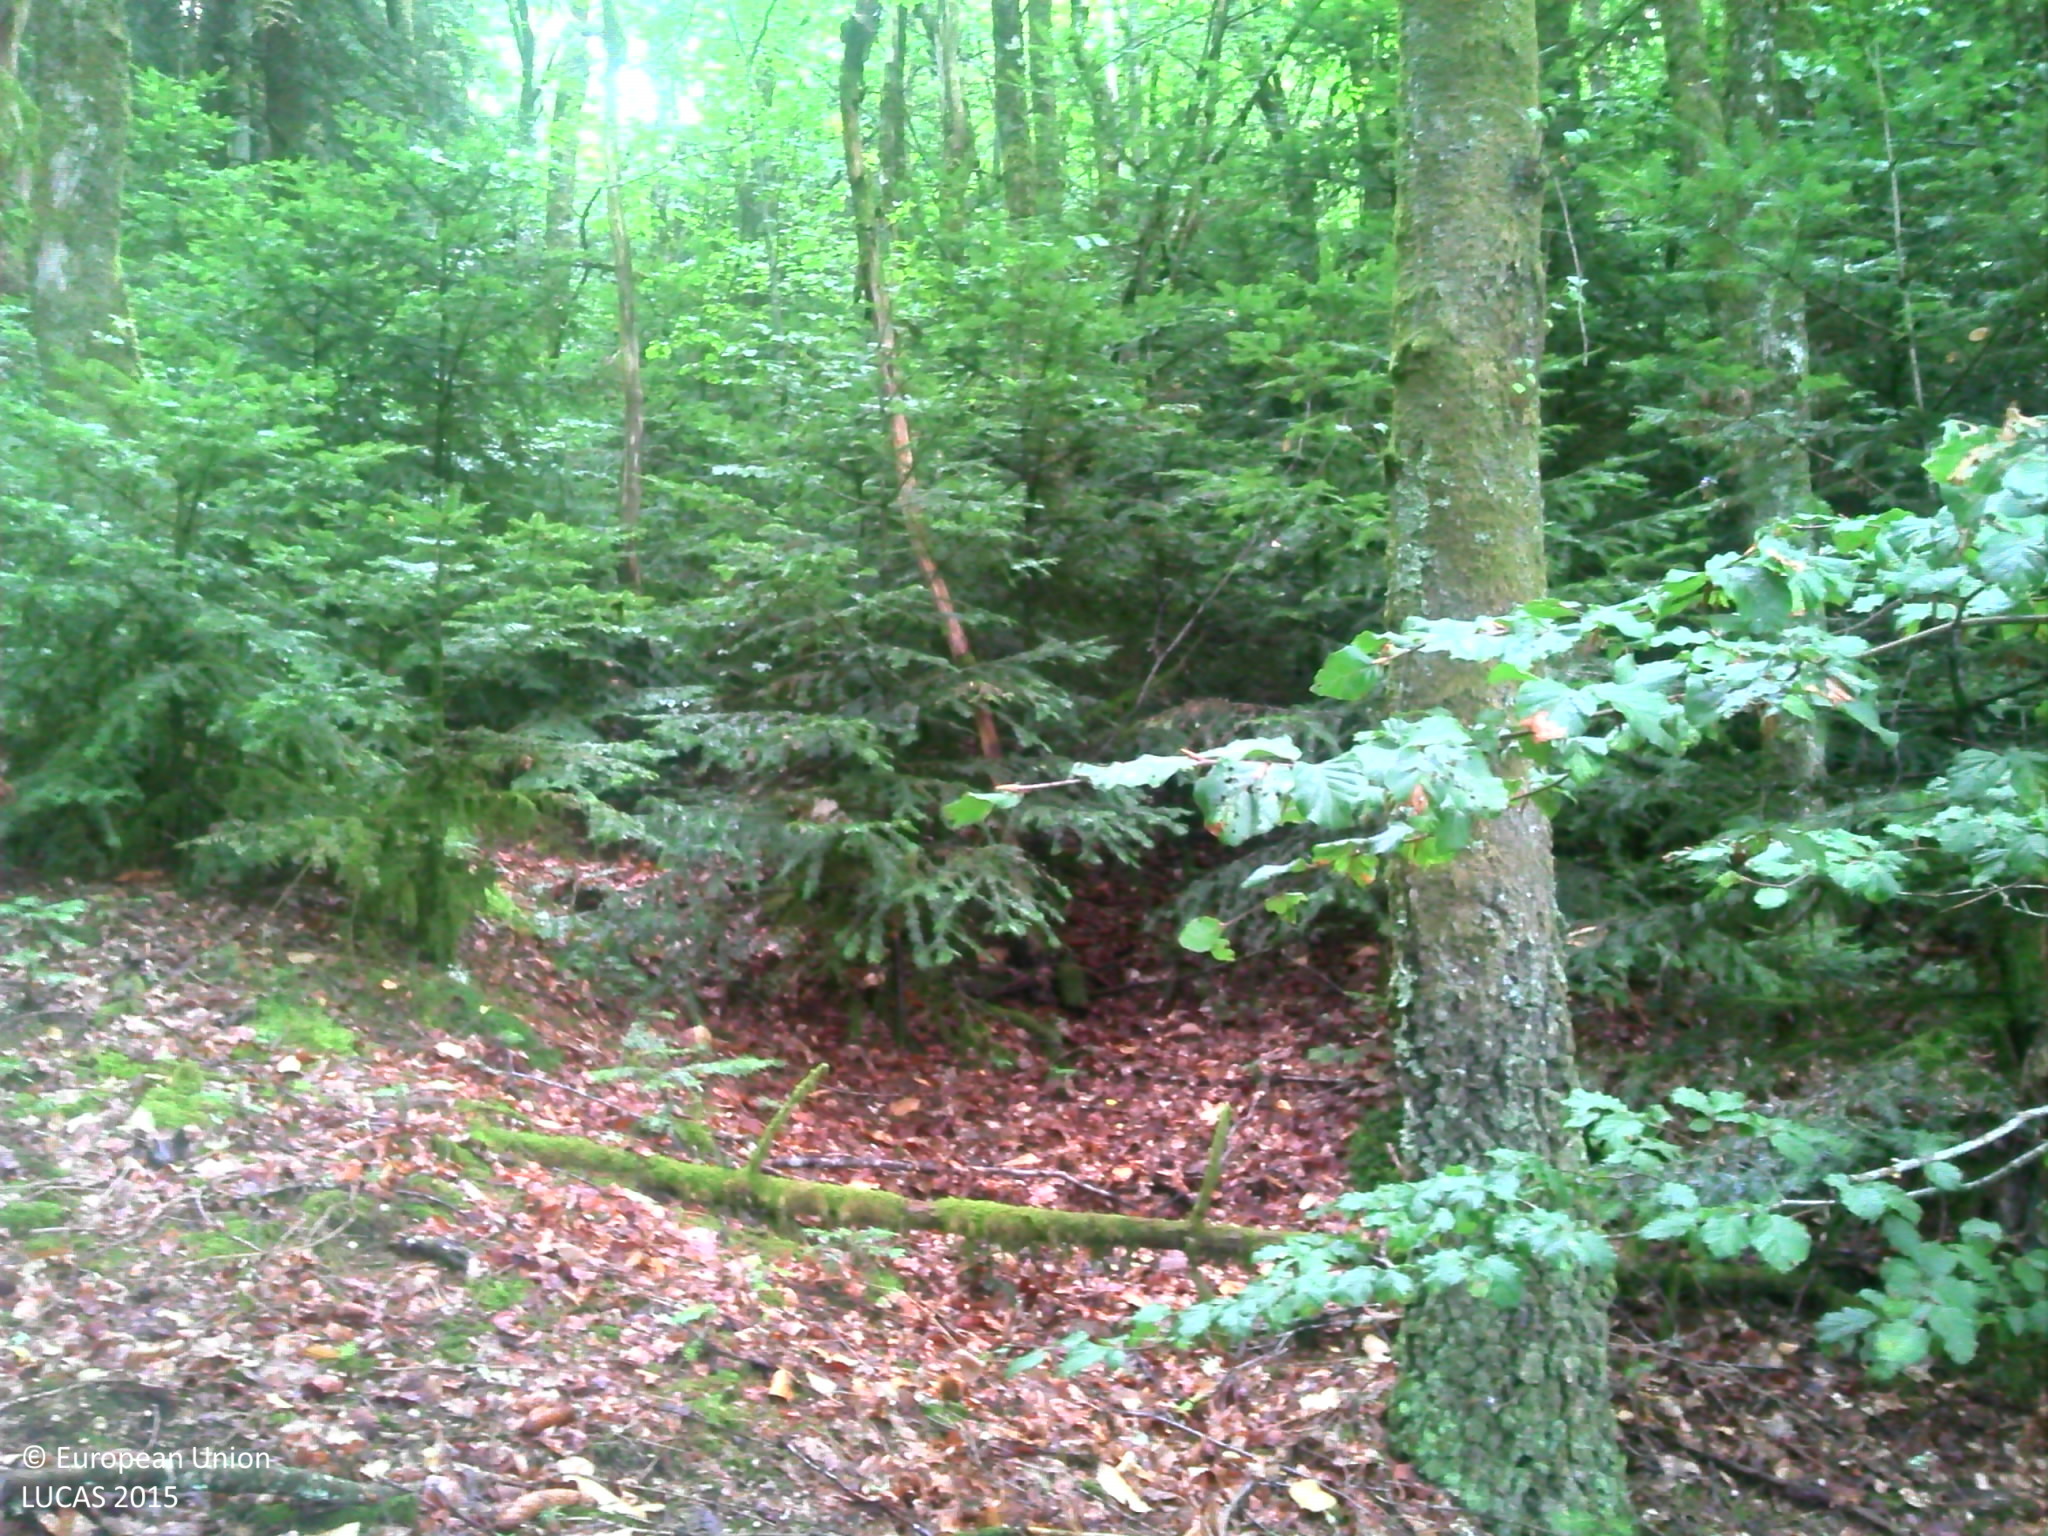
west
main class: Woodland
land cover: Pine dominated mixed woodland
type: mountainous beech forest
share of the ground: 50 - 75 %
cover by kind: coniferous forest trees 40 %, broadleaved forest trees 30 %, herbaceous plants 20 %, lichens and mosses 10 %
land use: Forestry
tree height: > 5 m
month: August
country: FR
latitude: 45.4625
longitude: 1.8747
